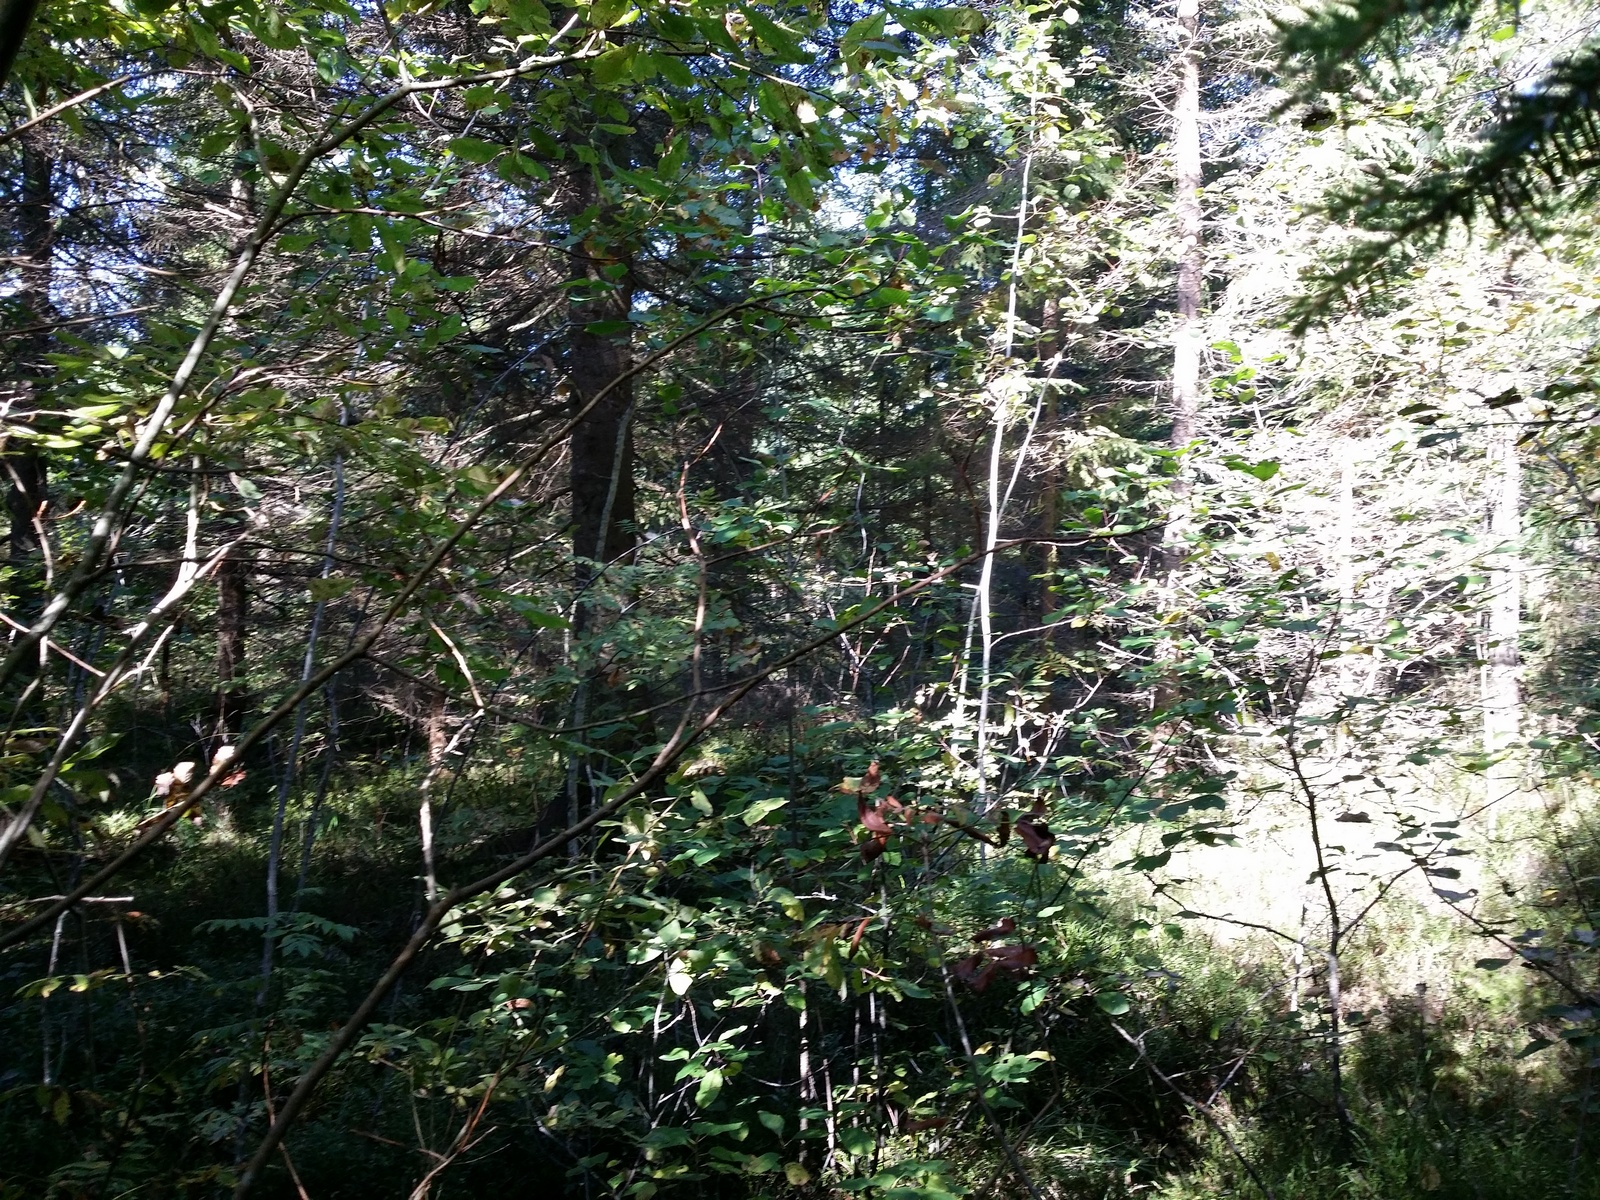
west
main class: Woodland
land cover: Spruce dominated mixed woodland
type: hemiboreal forest and nemoral coniferous forest and mixed broadleaved-coniferous forest
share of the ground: > 75 %
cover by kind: coniferous forest trees 50 %, broadleaved forest trees 35 %, lichens and mosses 10 %, herbaceous plants 5 %
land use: Forestry
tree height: > 5 m
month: September
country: LV
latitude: 57.1905
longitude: 27.6035
